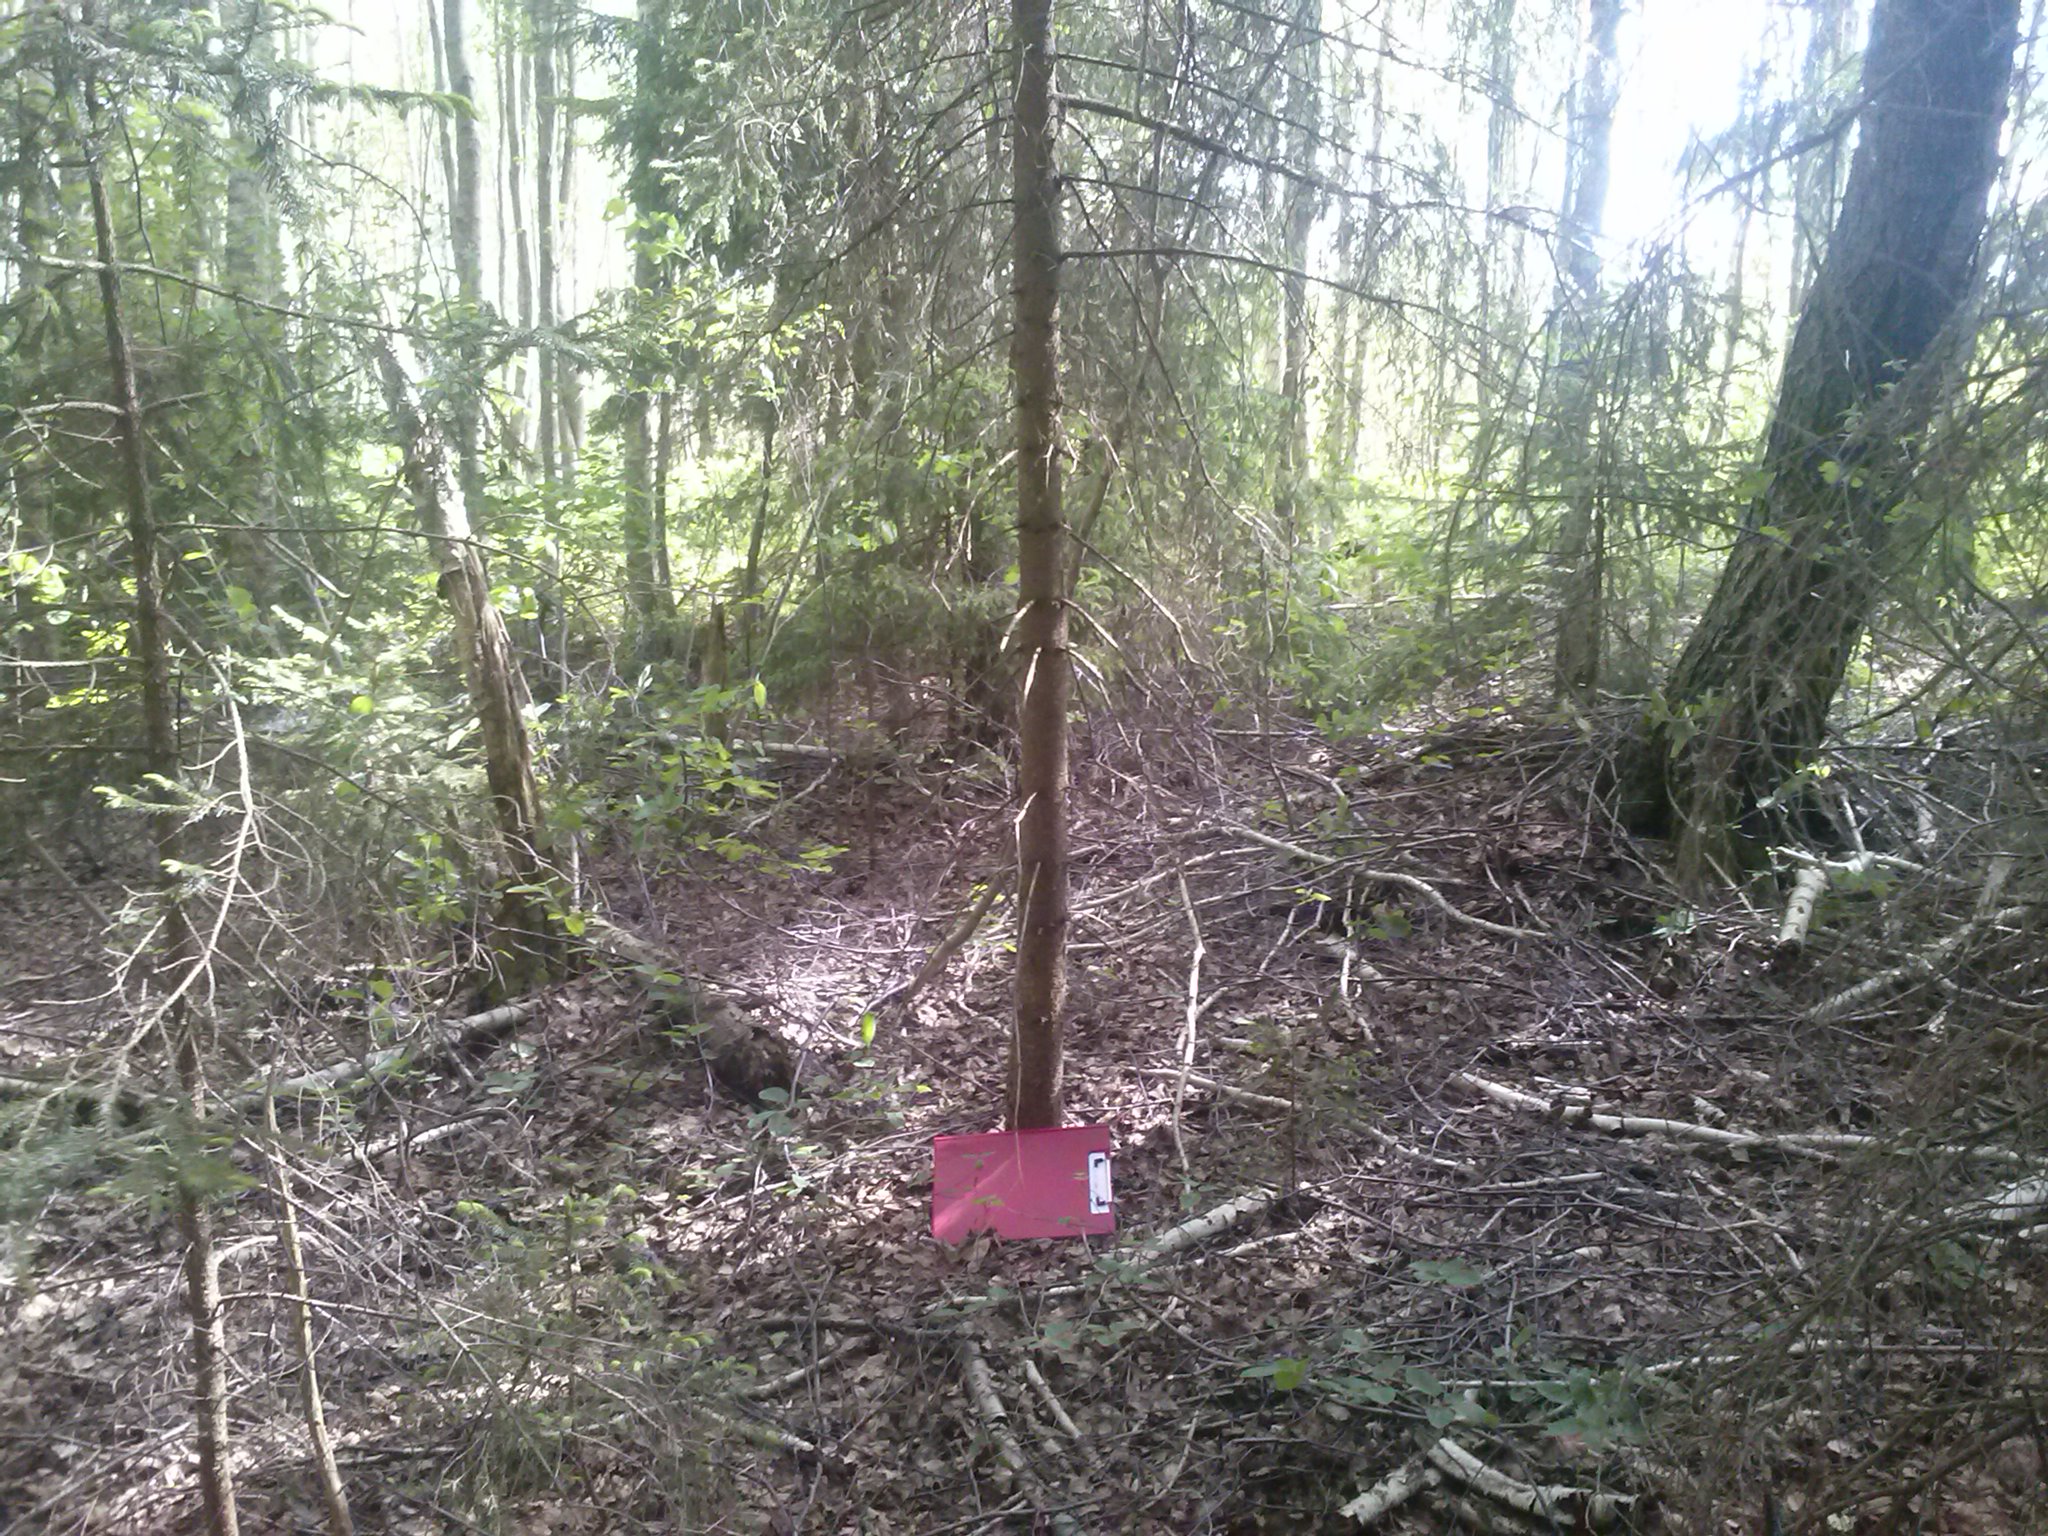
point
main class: Woodland
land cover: Spruce dominated mixed woodland
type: hemiboreal forest and nemoral coniferous forest and mixed broadleaved-coniferous forest
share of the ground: > 75 %
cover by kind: coniferous forest trees 60 %, broadleaved forest trees 25 %, herbaceous plants 5 %, unconsolidated bare surface 5 %
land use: Forestry
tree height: > 5 m
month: June
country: LV
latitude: 56.2820
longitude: 26.8117
